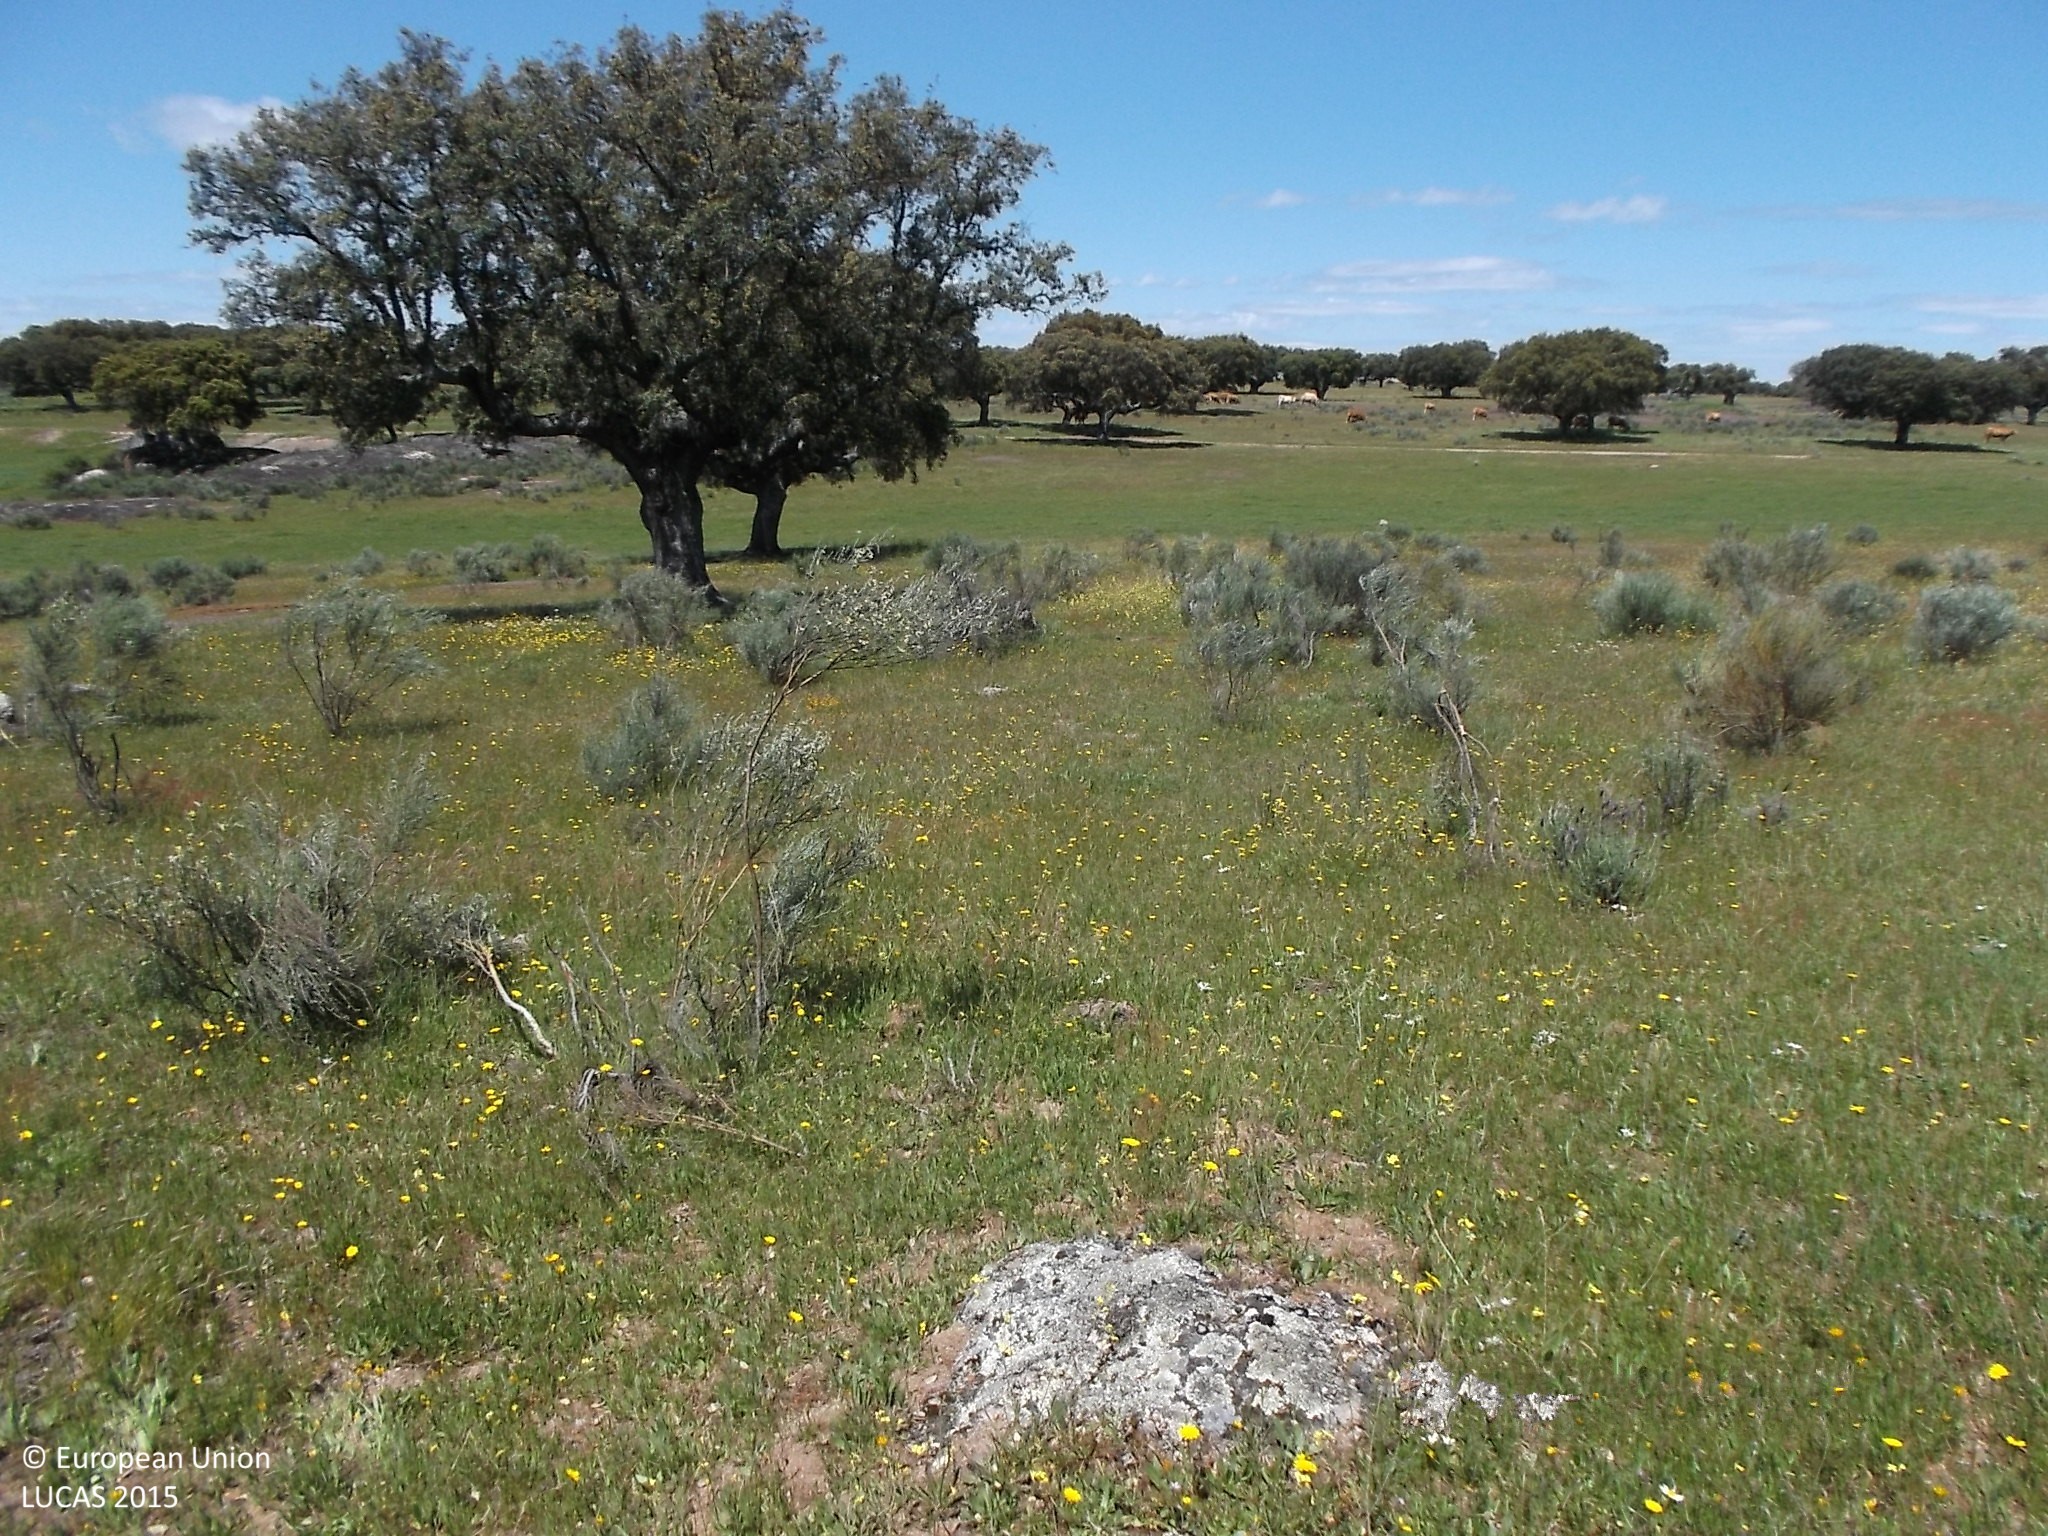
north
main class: Woodland
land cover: Broadleaved woodland
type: broadleaved evergreen forest
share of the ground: 10 - 25 %
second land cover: Grassland without tree/shrub cover
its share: > 75 %
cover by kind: herbaceous plants 70 %, broadleaved forest trees 20 %, shrubs 10 %
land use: Forestry
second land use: Agriculture (excluding fallow land and kitchen gardens)
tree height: > 5 m
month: May
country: ES
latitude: 40.9091
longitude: -6.2464
